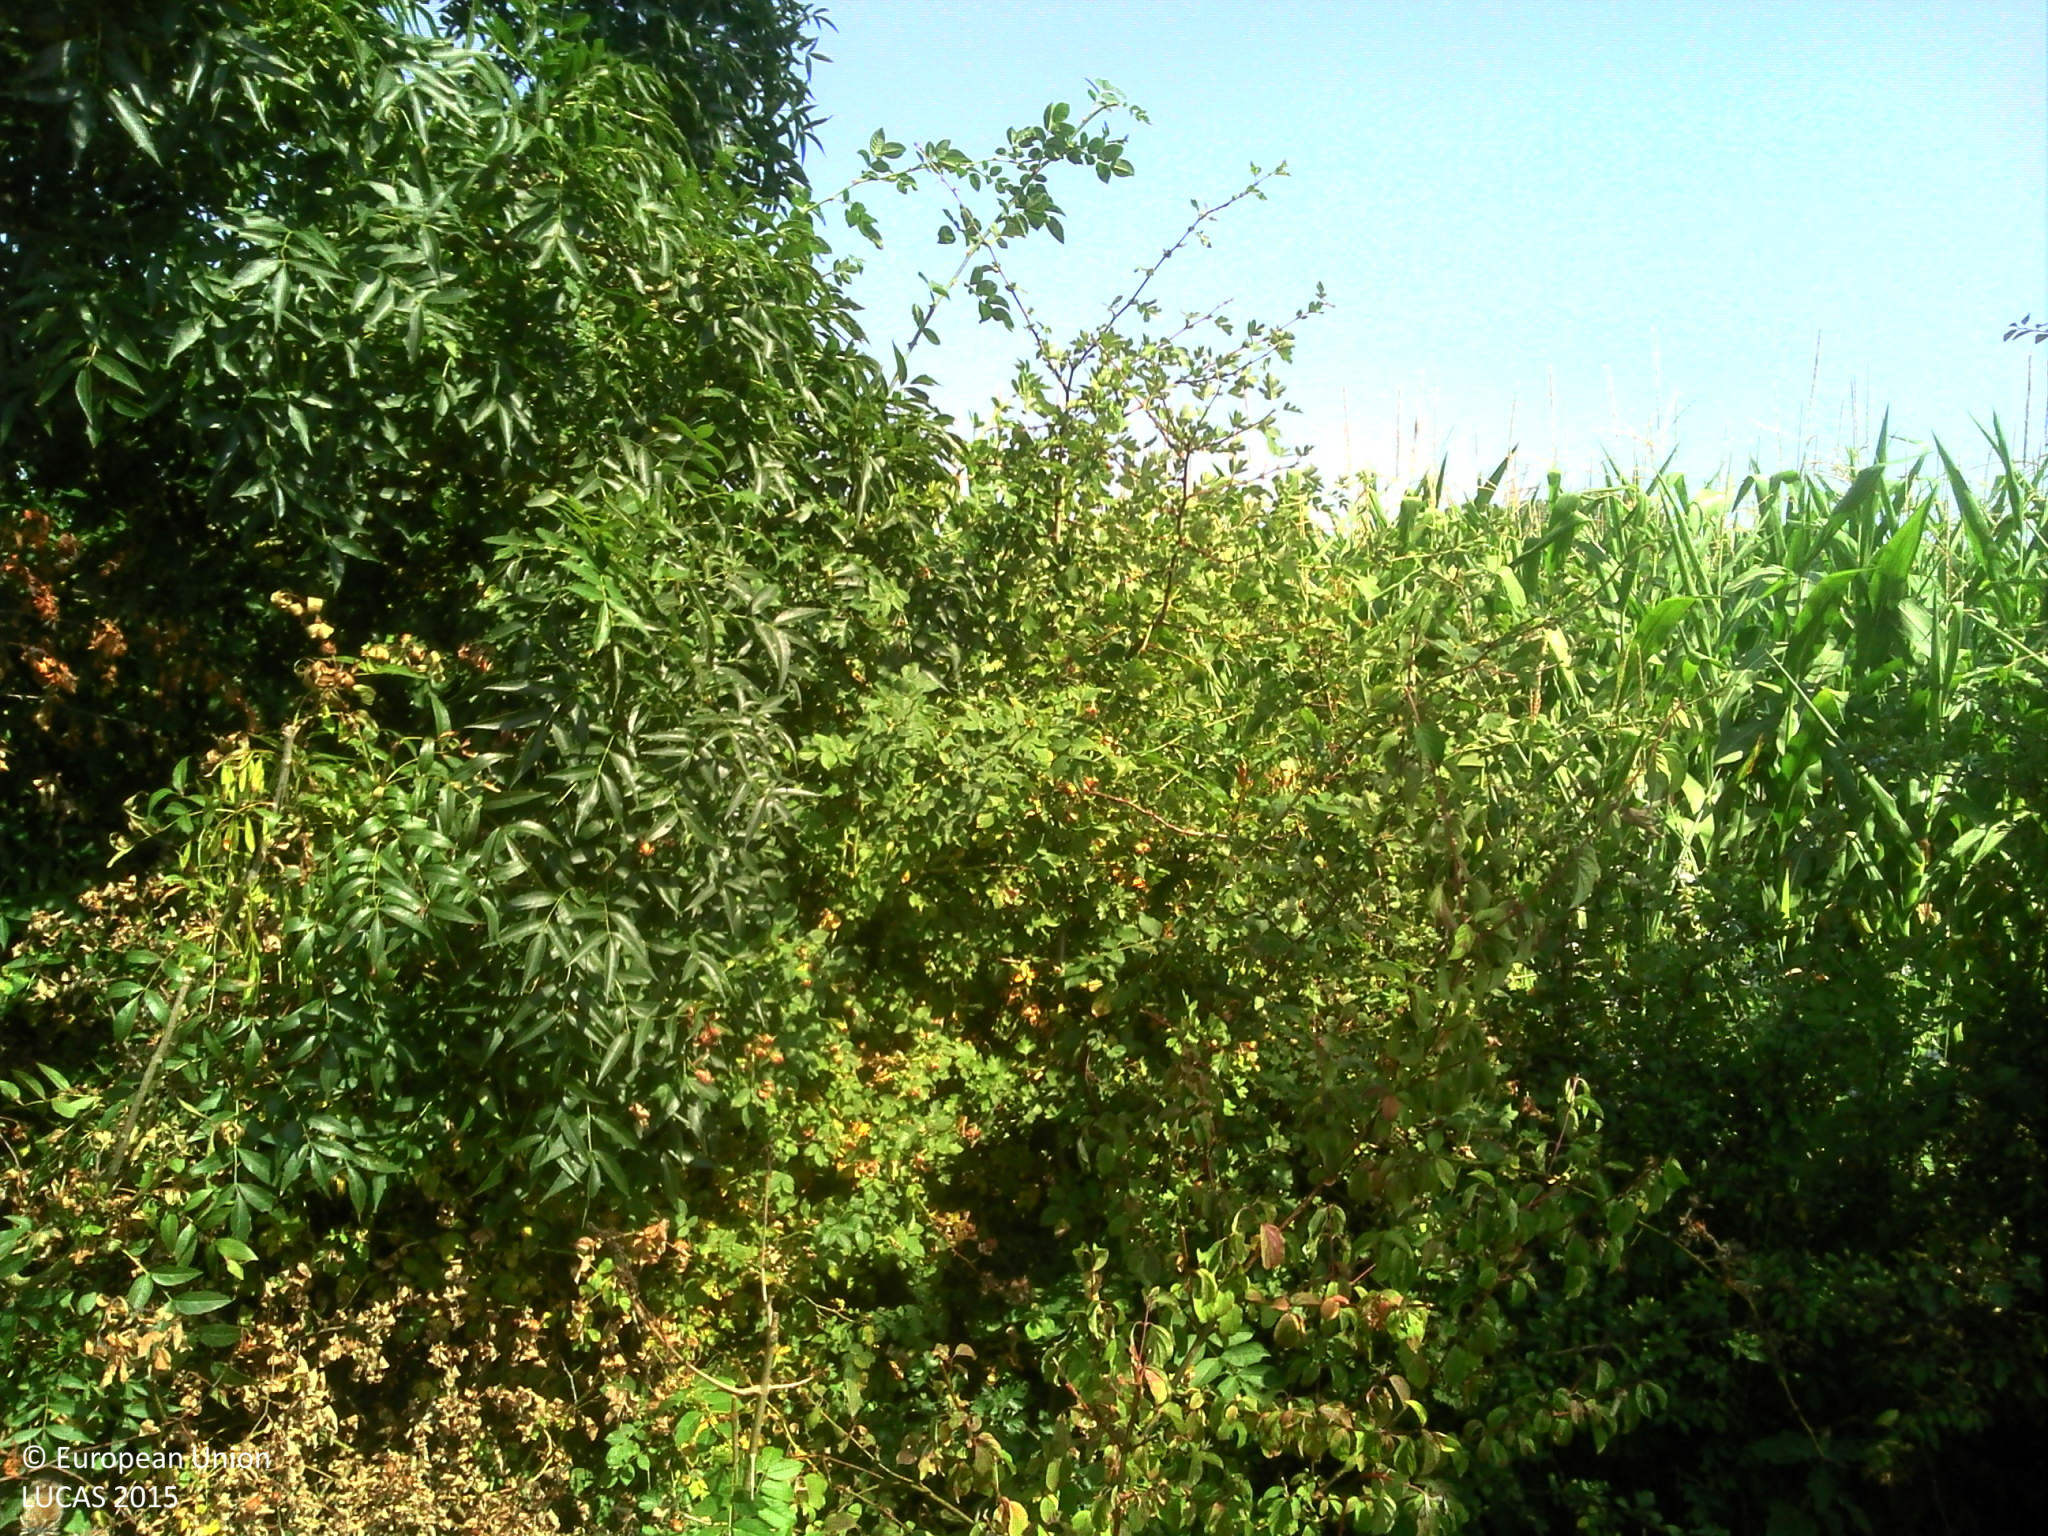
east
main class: Cropland
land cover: Maize
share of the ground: > 75 %
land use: Agriculture (excluding fallow land and kitchen gardens)
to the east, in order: Maize; Grassland without tree/shrub cover; Broadleaved woodland; Inland fresh running water; Abandoned hedges; Soya
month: July
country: FR
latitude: 46.9390
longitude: 5.0226
